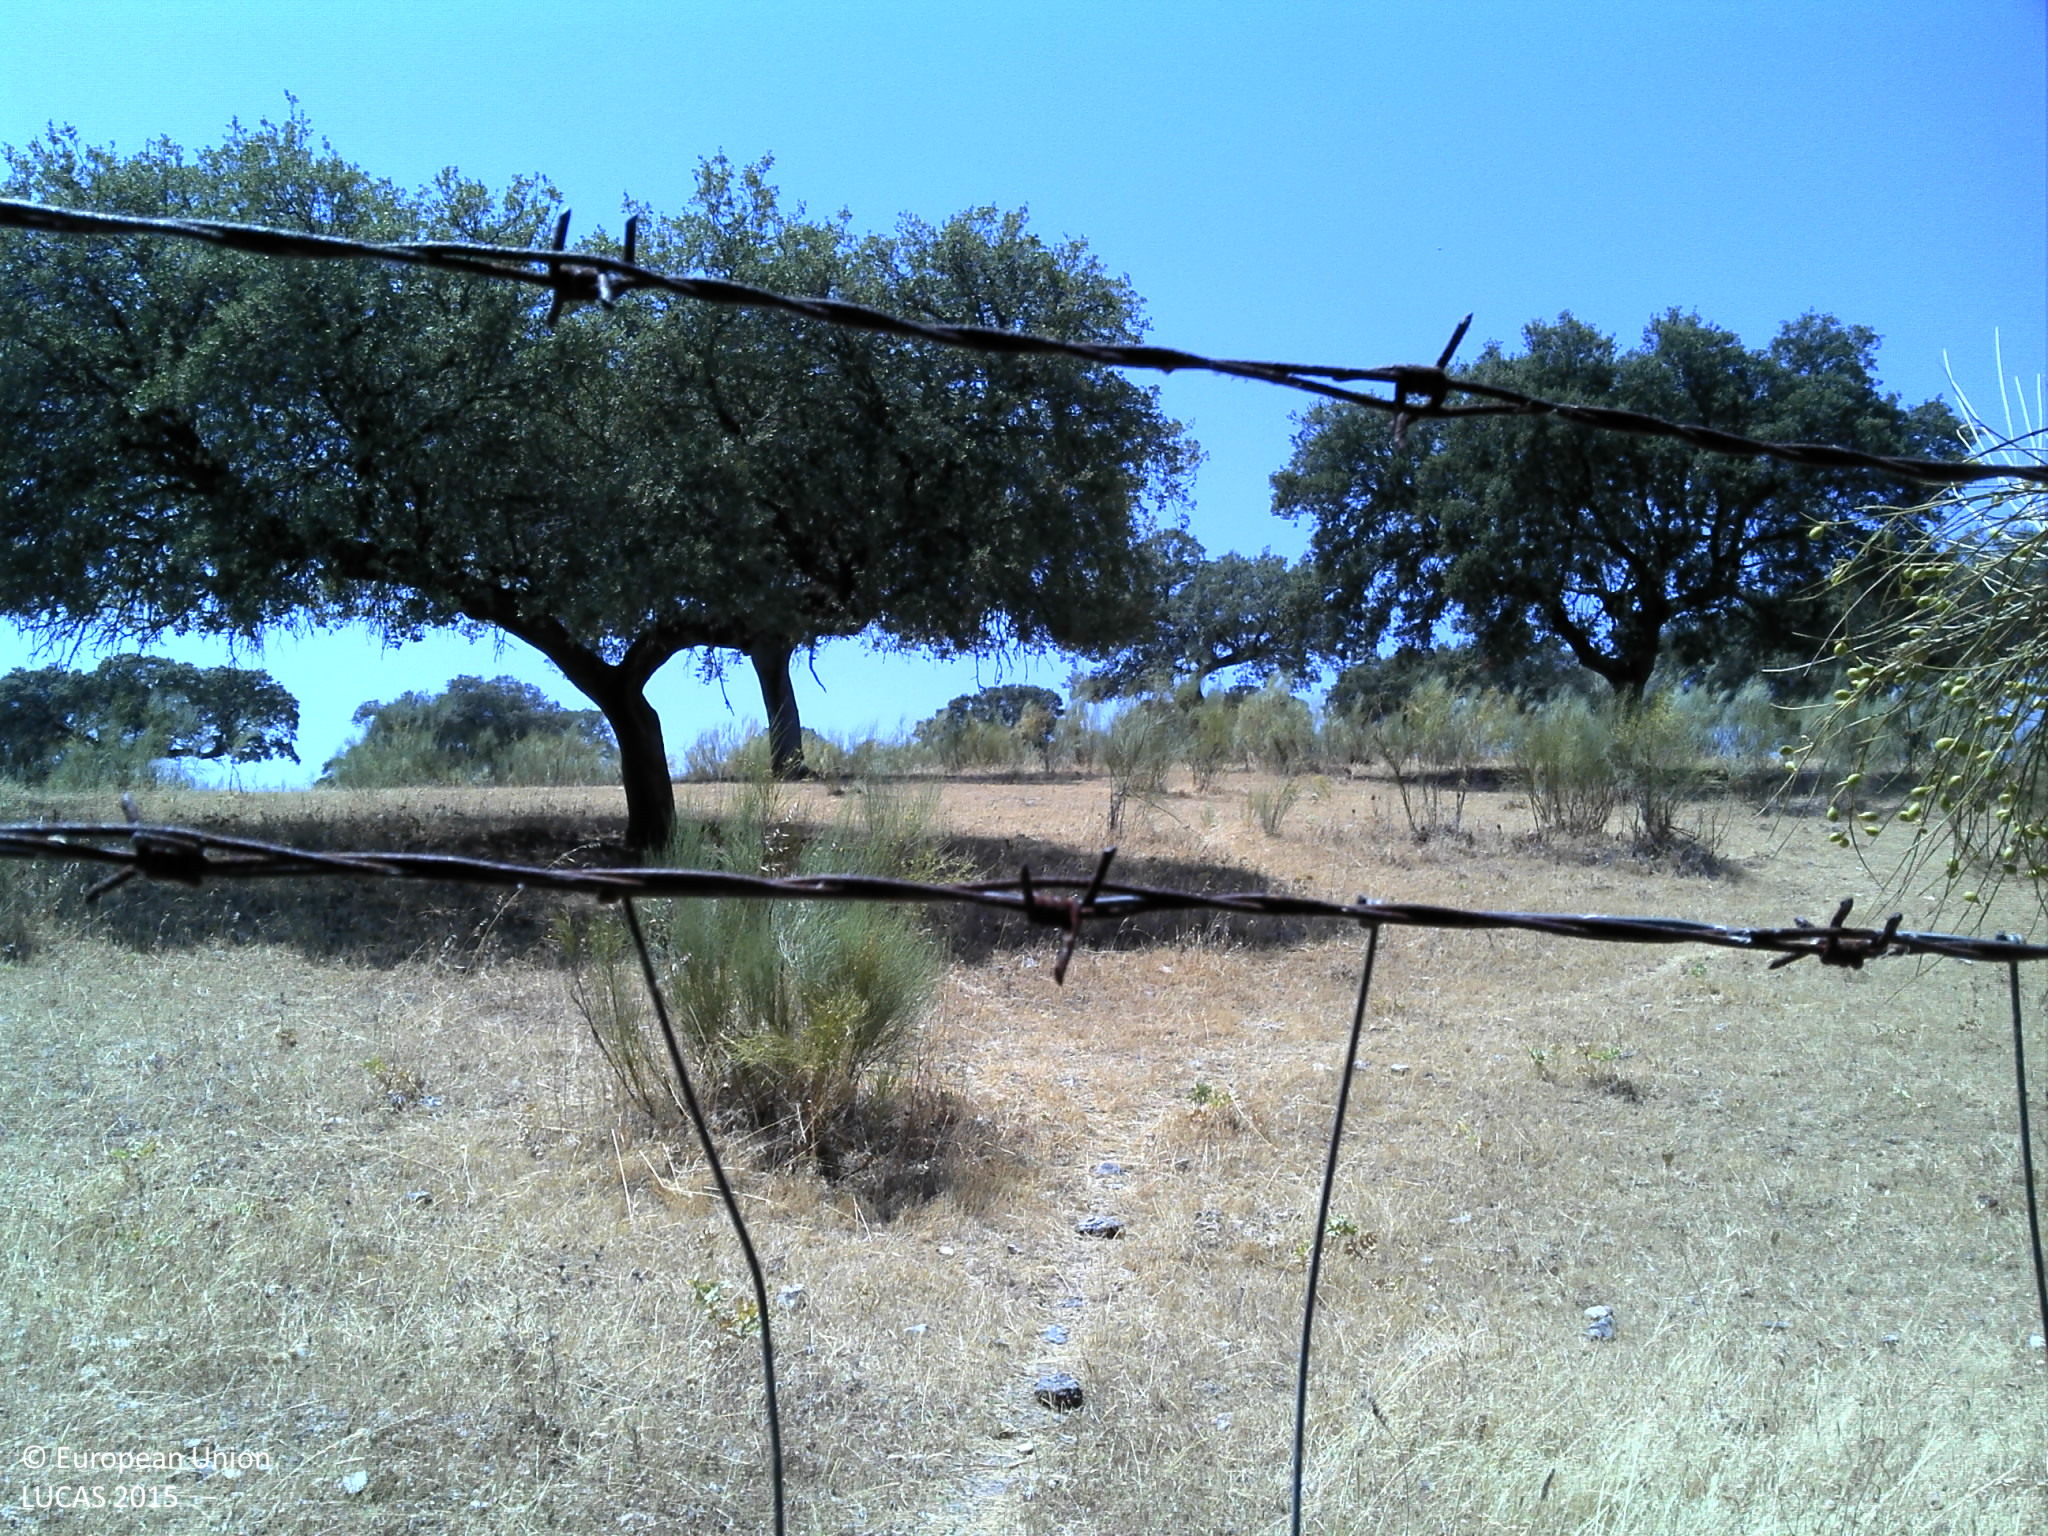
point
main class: Woodland
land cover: Broadleaved woodland
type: broadleaved evergreen forest
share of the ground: 50 - 75 %
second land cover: Grassland without tree/shrub cover
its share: 25 - 50 %
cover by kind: broadleaved forest trees 50 %, herbaceous plants 30 %, unconsolidated bare surface 20 %
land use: Forestry
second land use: Agriculture (excluding fallow land and kitchen gardens)
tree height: > 5 m
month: June
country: PT
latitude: 38.2105
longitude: -7.3450
